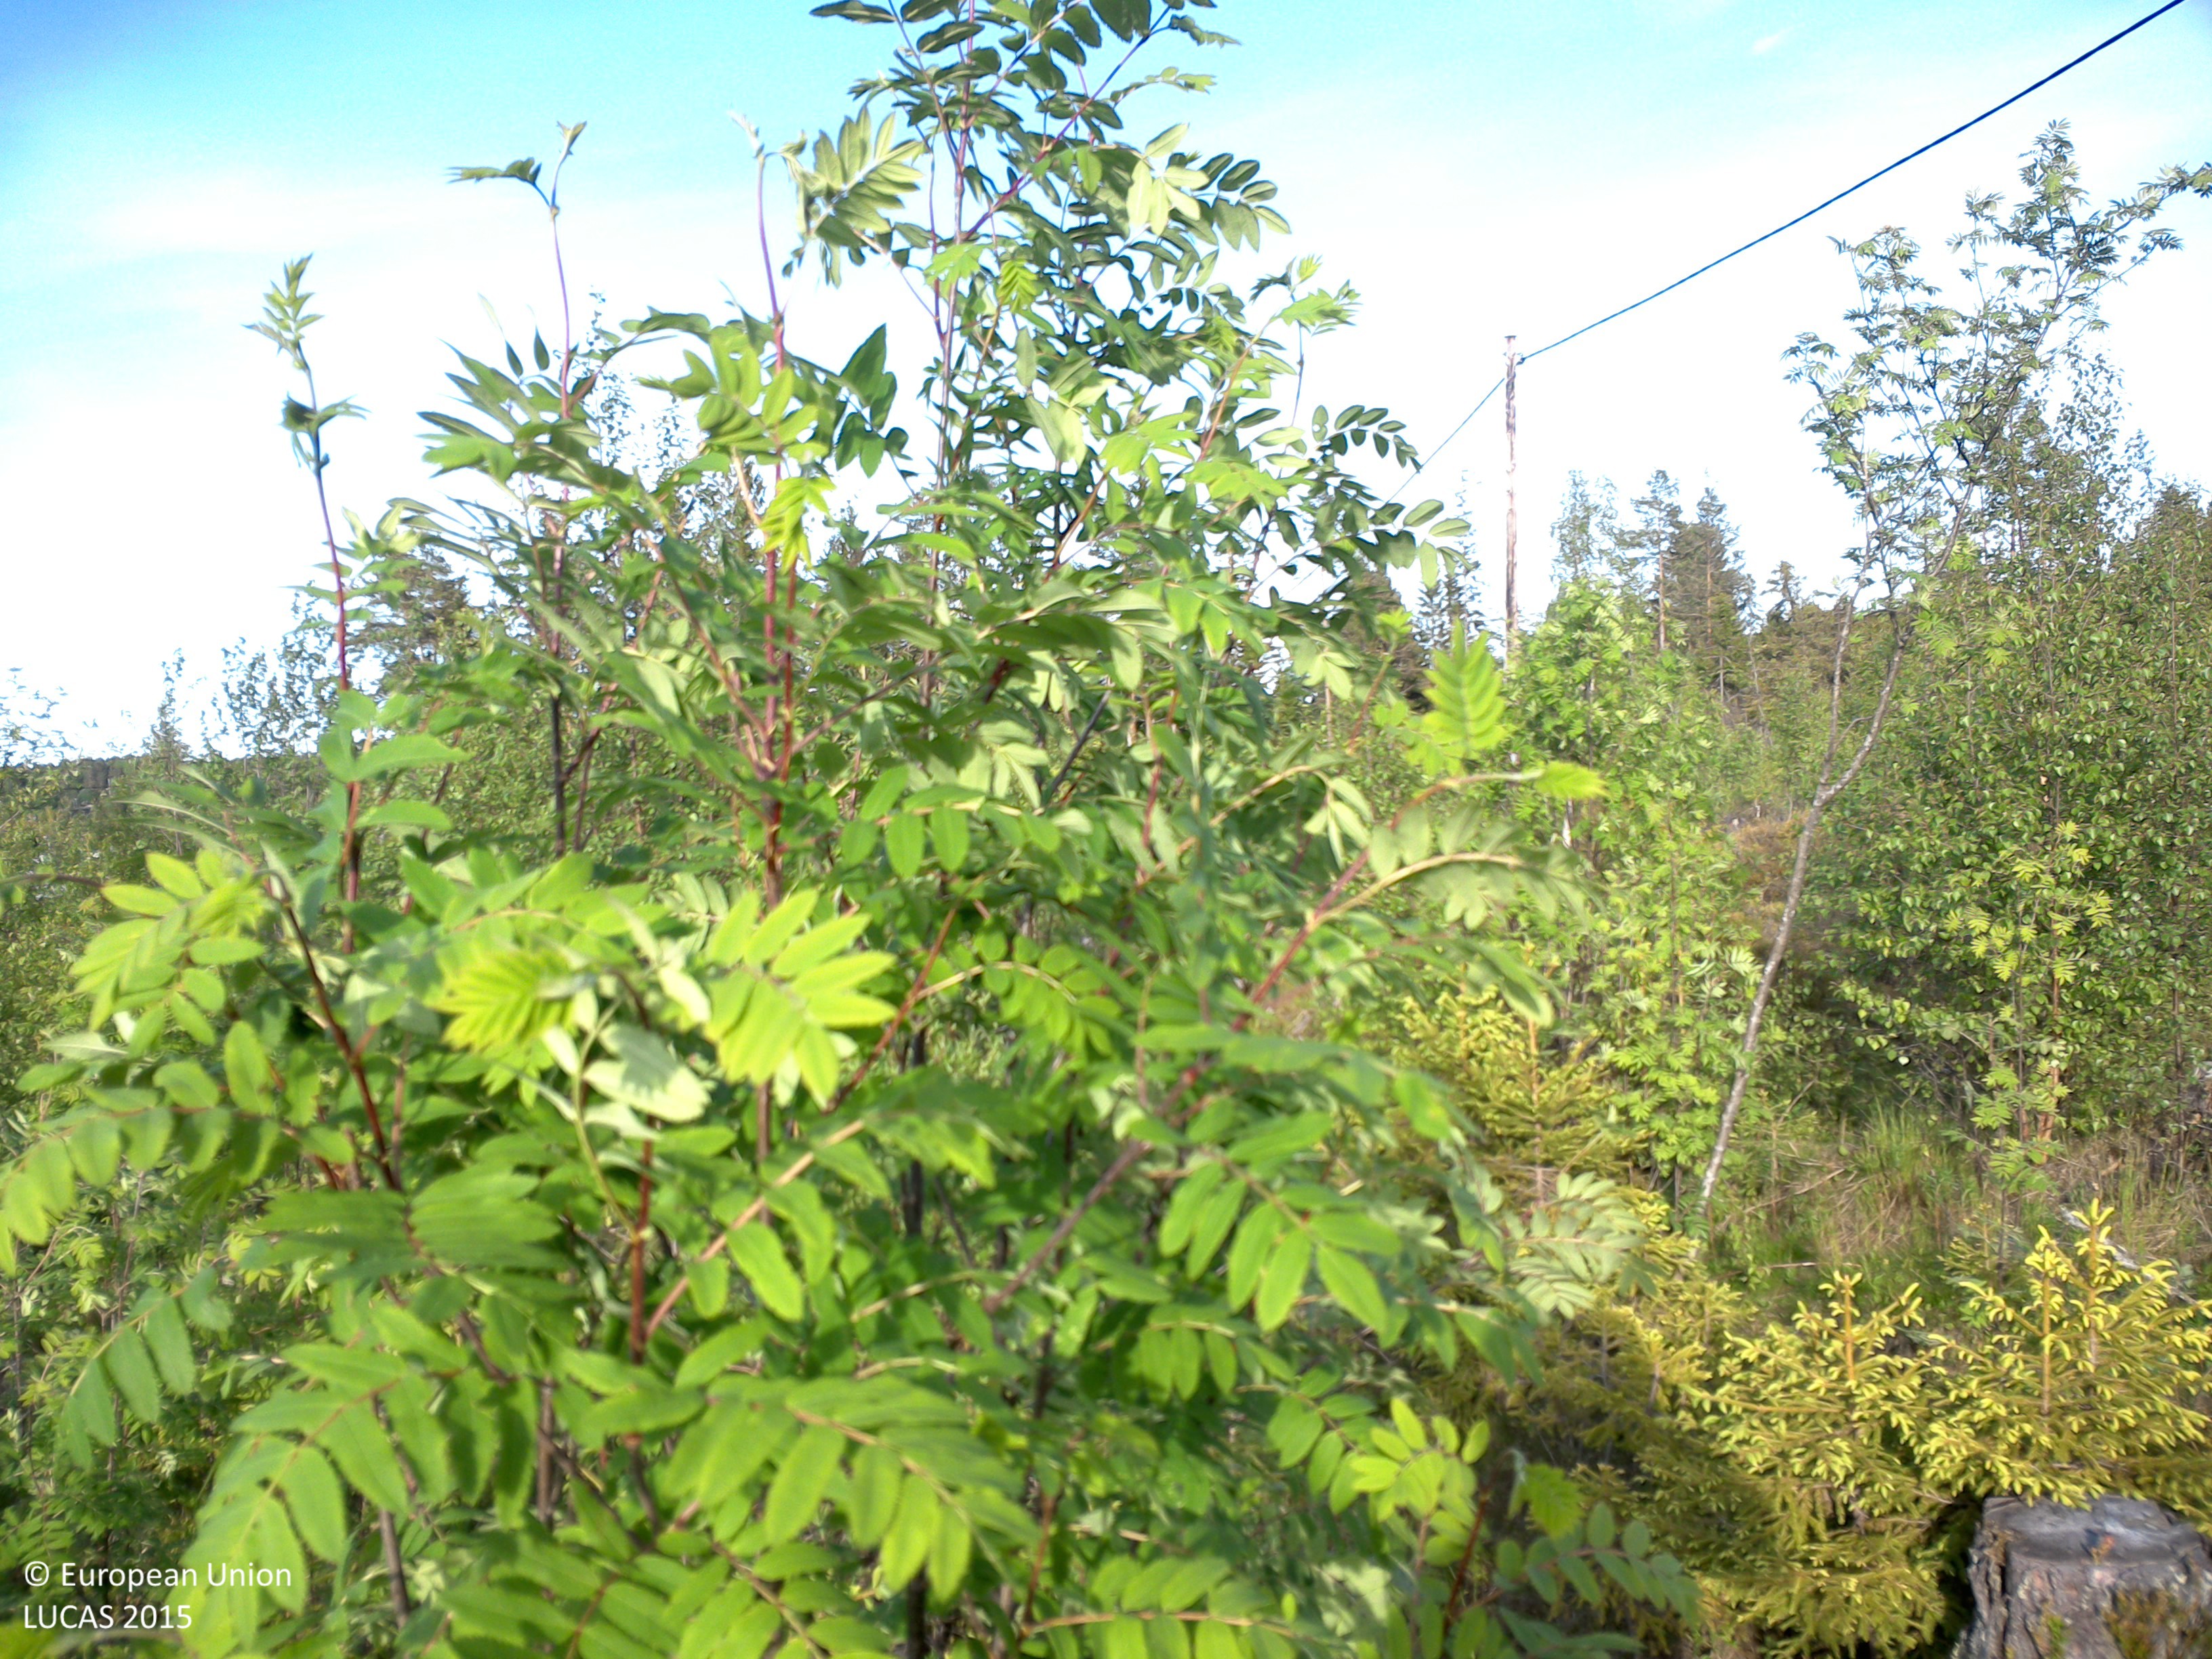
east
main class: Woodland
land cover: Broadleaved woodland
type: boreal forest
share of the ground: 10 - 25 %
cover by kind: herbaceous plants 85 %, broadleaved forest trees 15 %
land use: Forestry
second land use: Sport
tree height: < 5 m
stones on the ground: < 10 %
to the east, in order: Broadleaved woodland; Tracks; Electric lines; Spruce dominated mixed woodland; Artificial constructions in urban areas
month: June
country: SE
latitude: 62.6416
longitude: 17.8797
